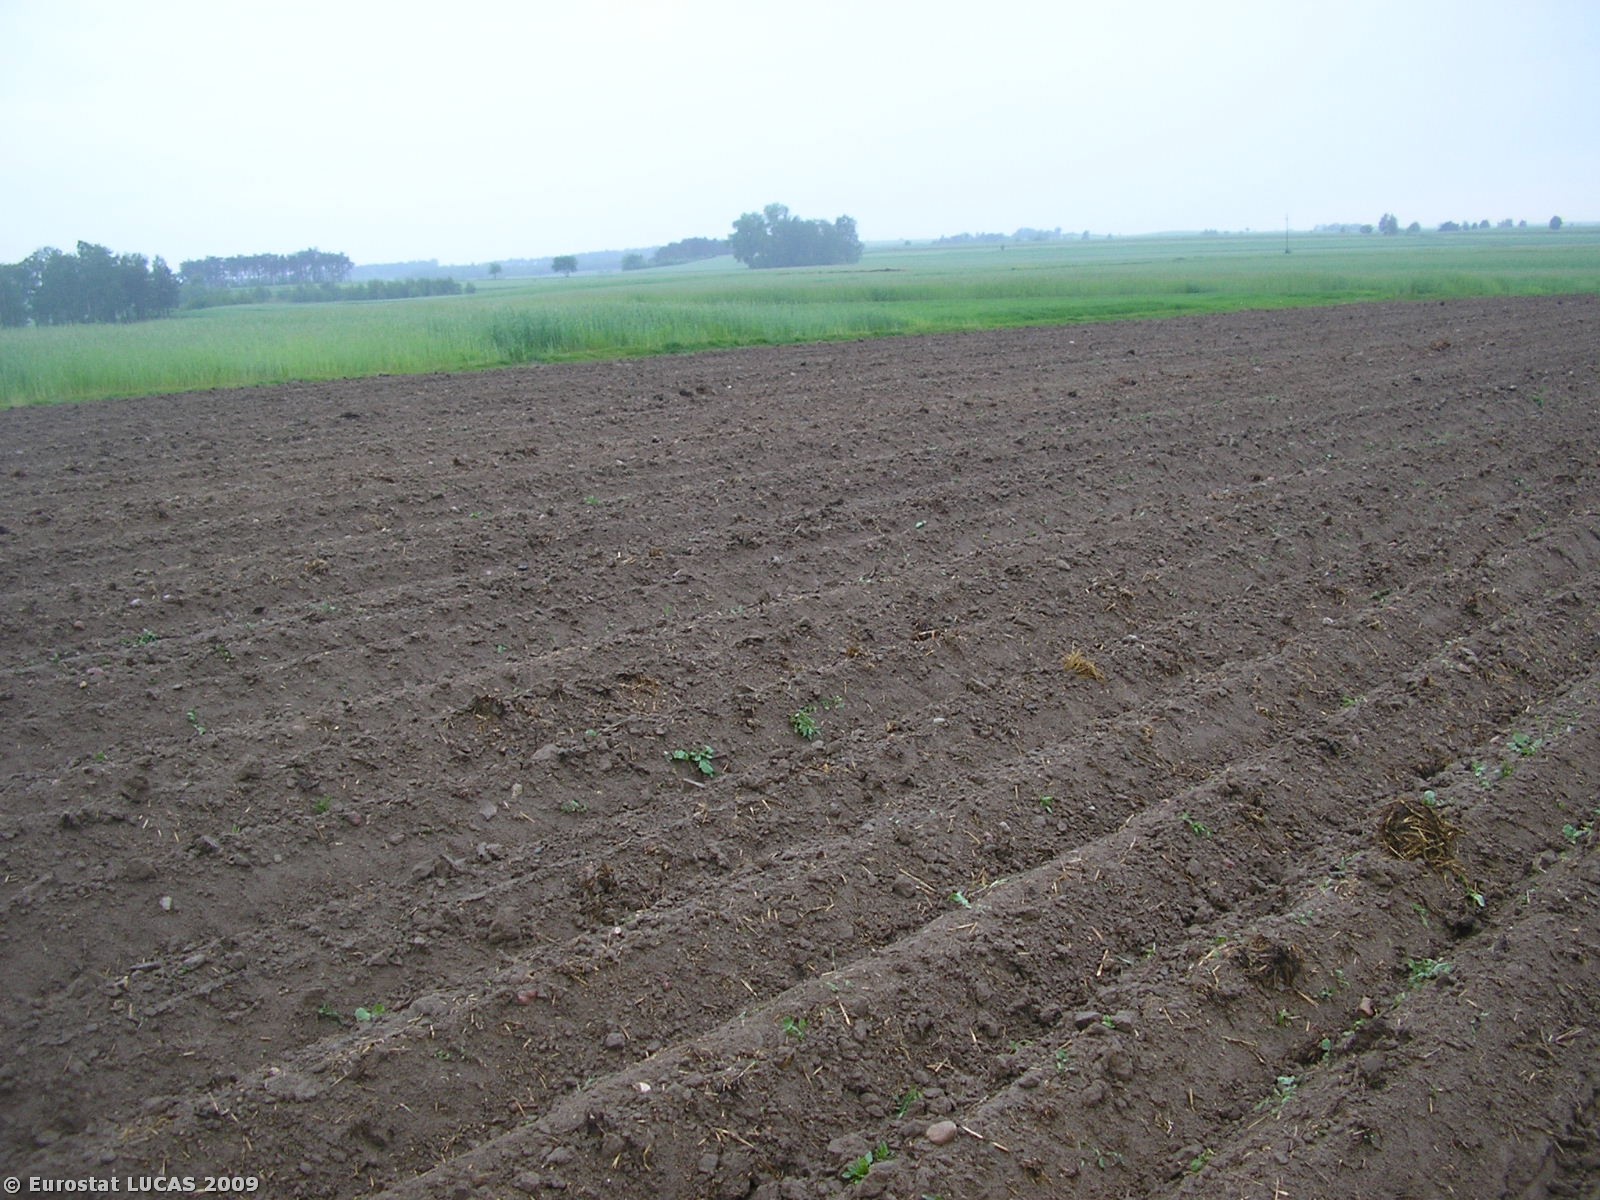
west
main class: Cropland
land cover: Rye
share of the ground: > 75 %
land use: Agriculture (excluding fallow land and kitchen gardens)
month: May
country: PL
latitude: 51.7892
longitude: 20.0220
